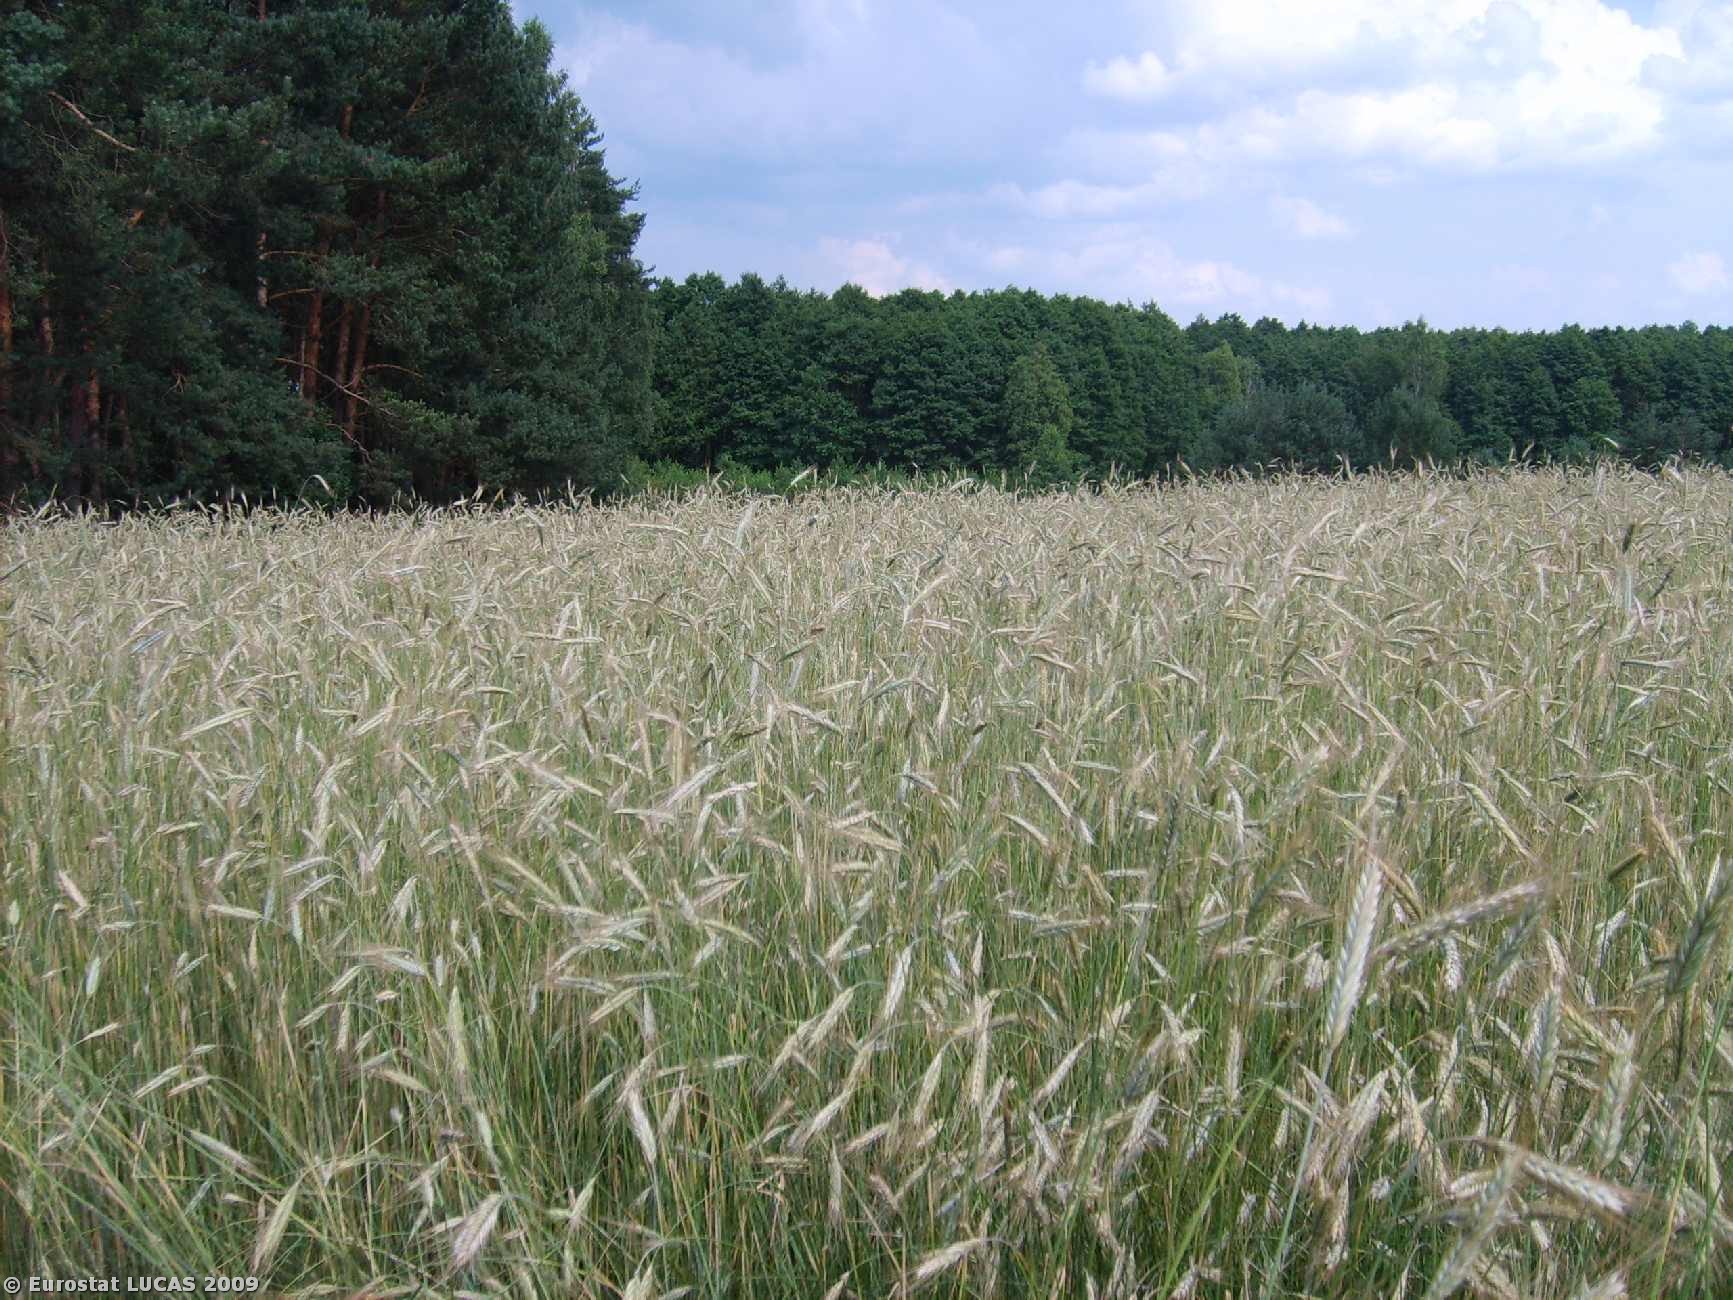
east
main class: Cropland
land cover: Rye
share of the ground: > 75 %
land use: Agriculture (excluding fallow land and kitchen gardens)
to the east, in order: Rye; Broadleaved woodland; Coniferous woodland; Grassland without tree/shrub cover; Abandoned hedges; Paved roads, cycling and walking lanes
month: July
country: PL
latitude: 50.9854
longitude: 23.9248
